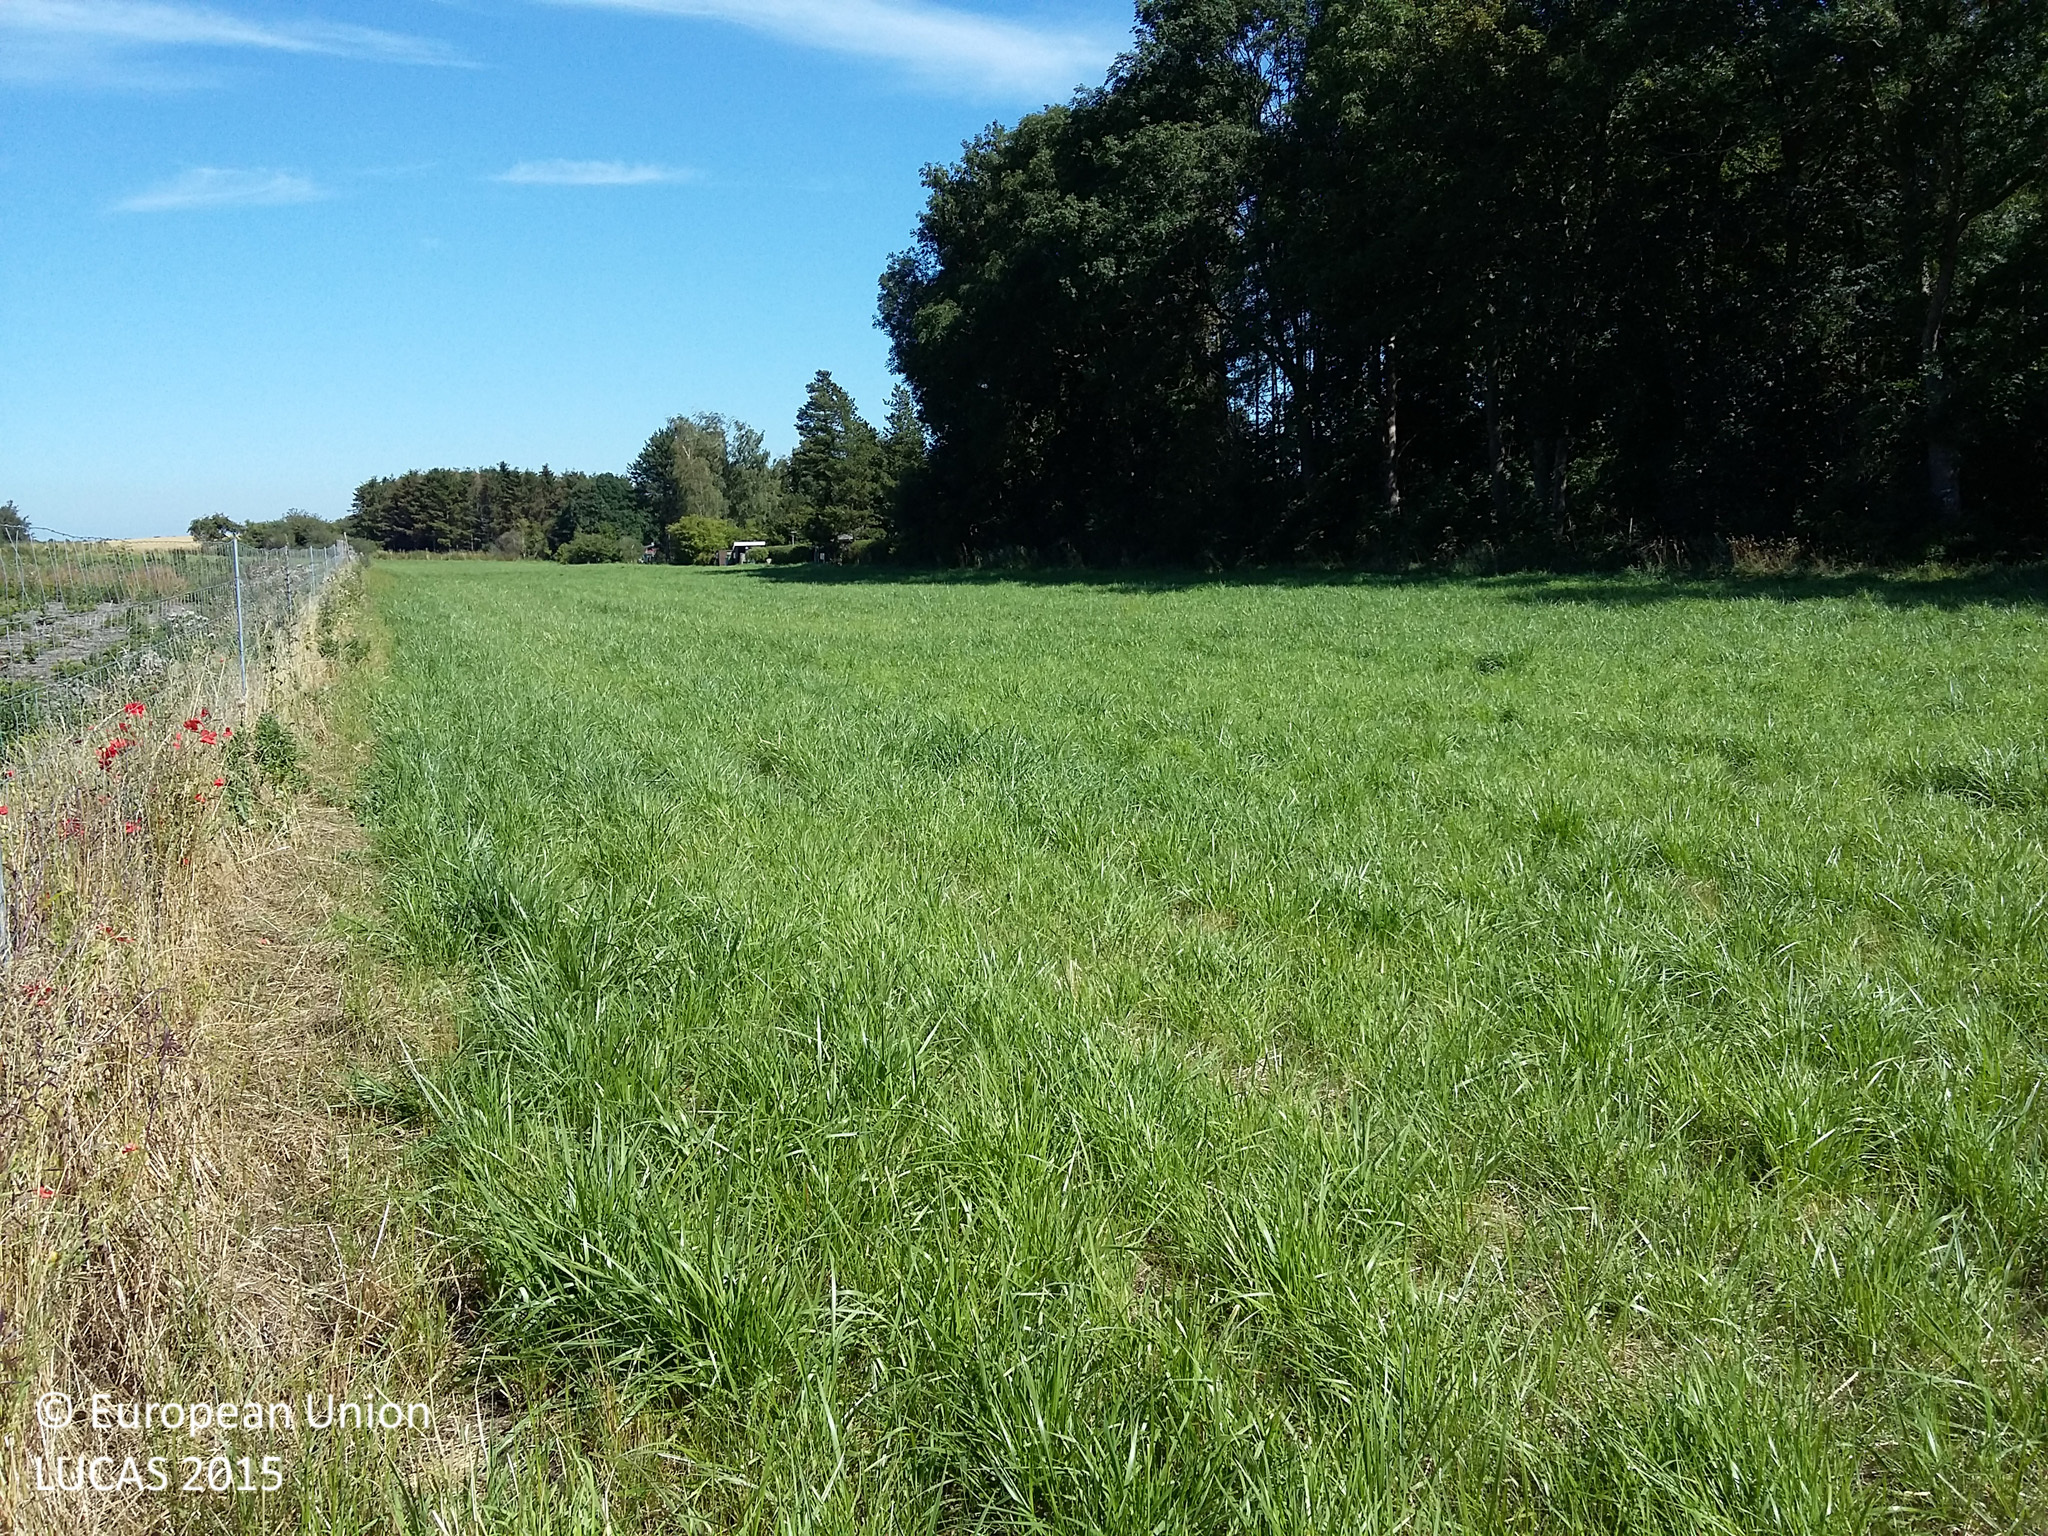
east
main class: Cropland
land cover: Nurseries
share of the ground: 10 - 25 %
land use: Agriculture (excluding fallow land and kitchen gardens)
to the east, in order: Nurseries; Shruby margins; Nurseries
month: August
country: DK
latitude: 55.6838
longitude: 12.1771
